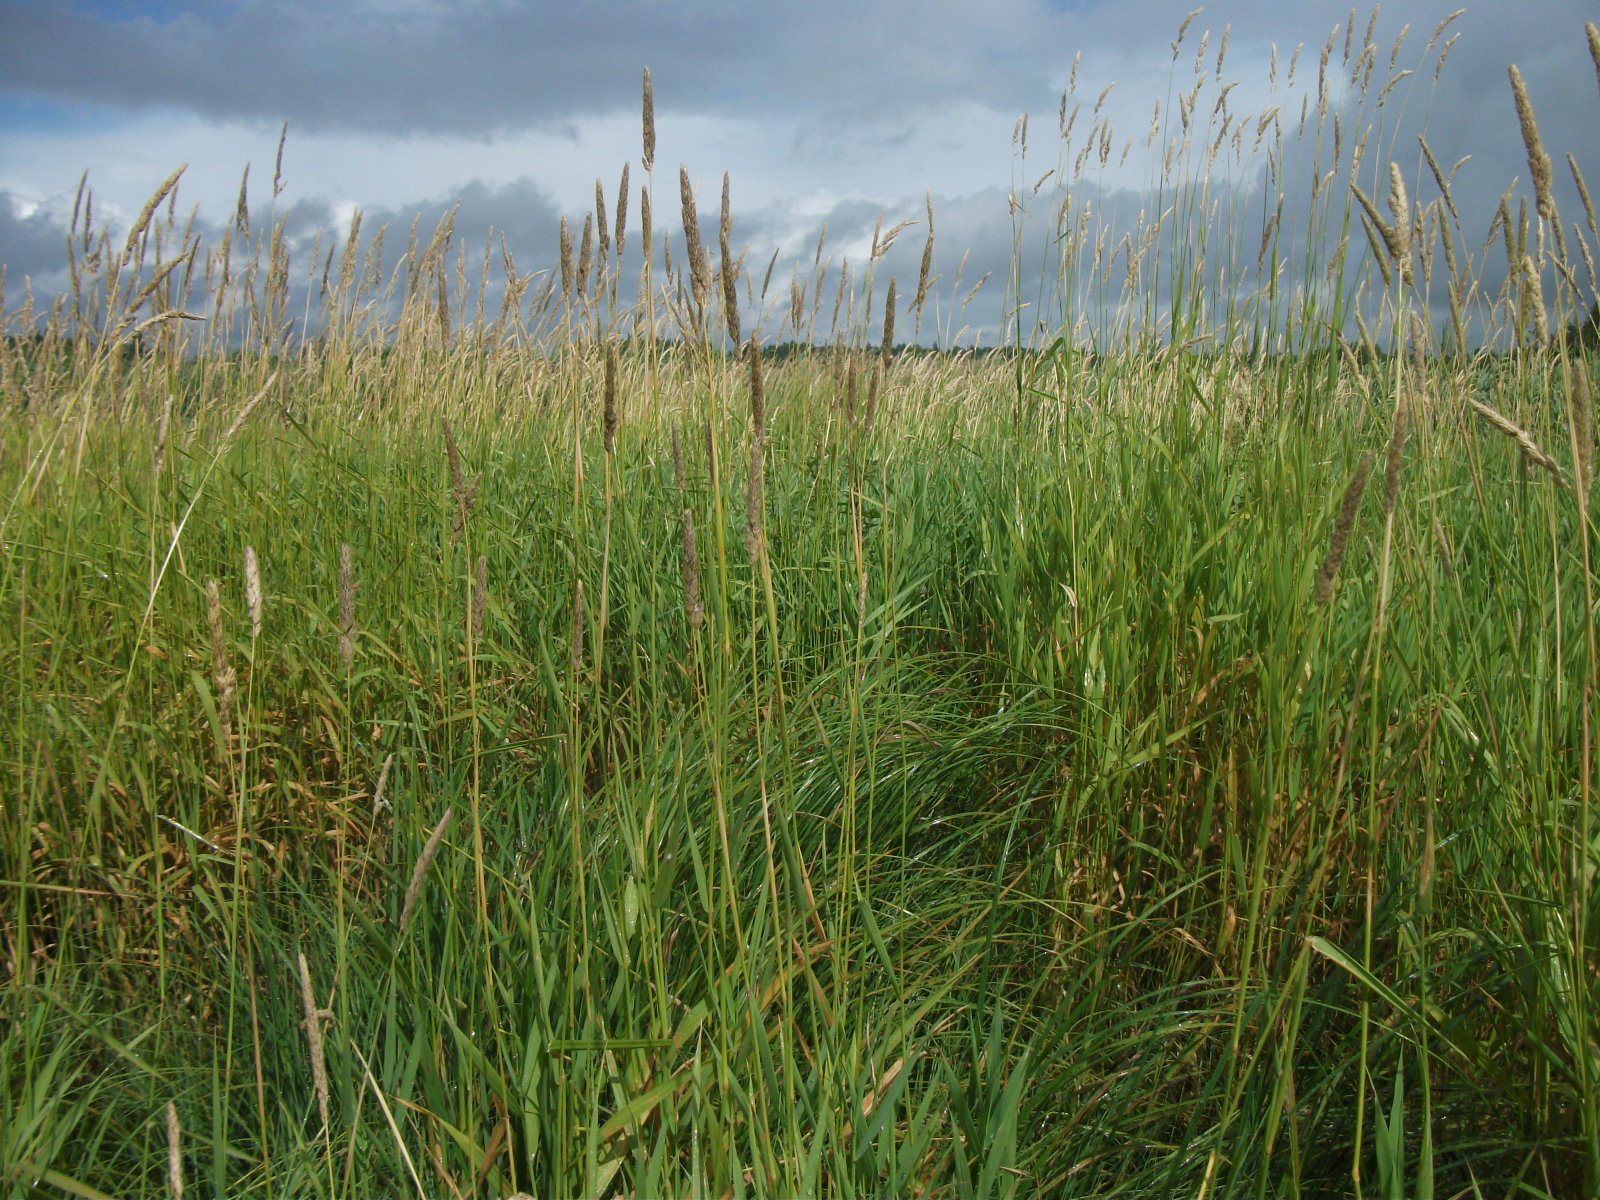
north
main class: Grassland
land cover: Grassland without tree/shrub cover
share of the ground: > 75 %
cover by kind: herbaceous plants 100 %
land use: Agriculture (excluding fallow land and kitchen gardens)
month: July
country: LV
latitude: 57.0078
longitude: 25.8860
